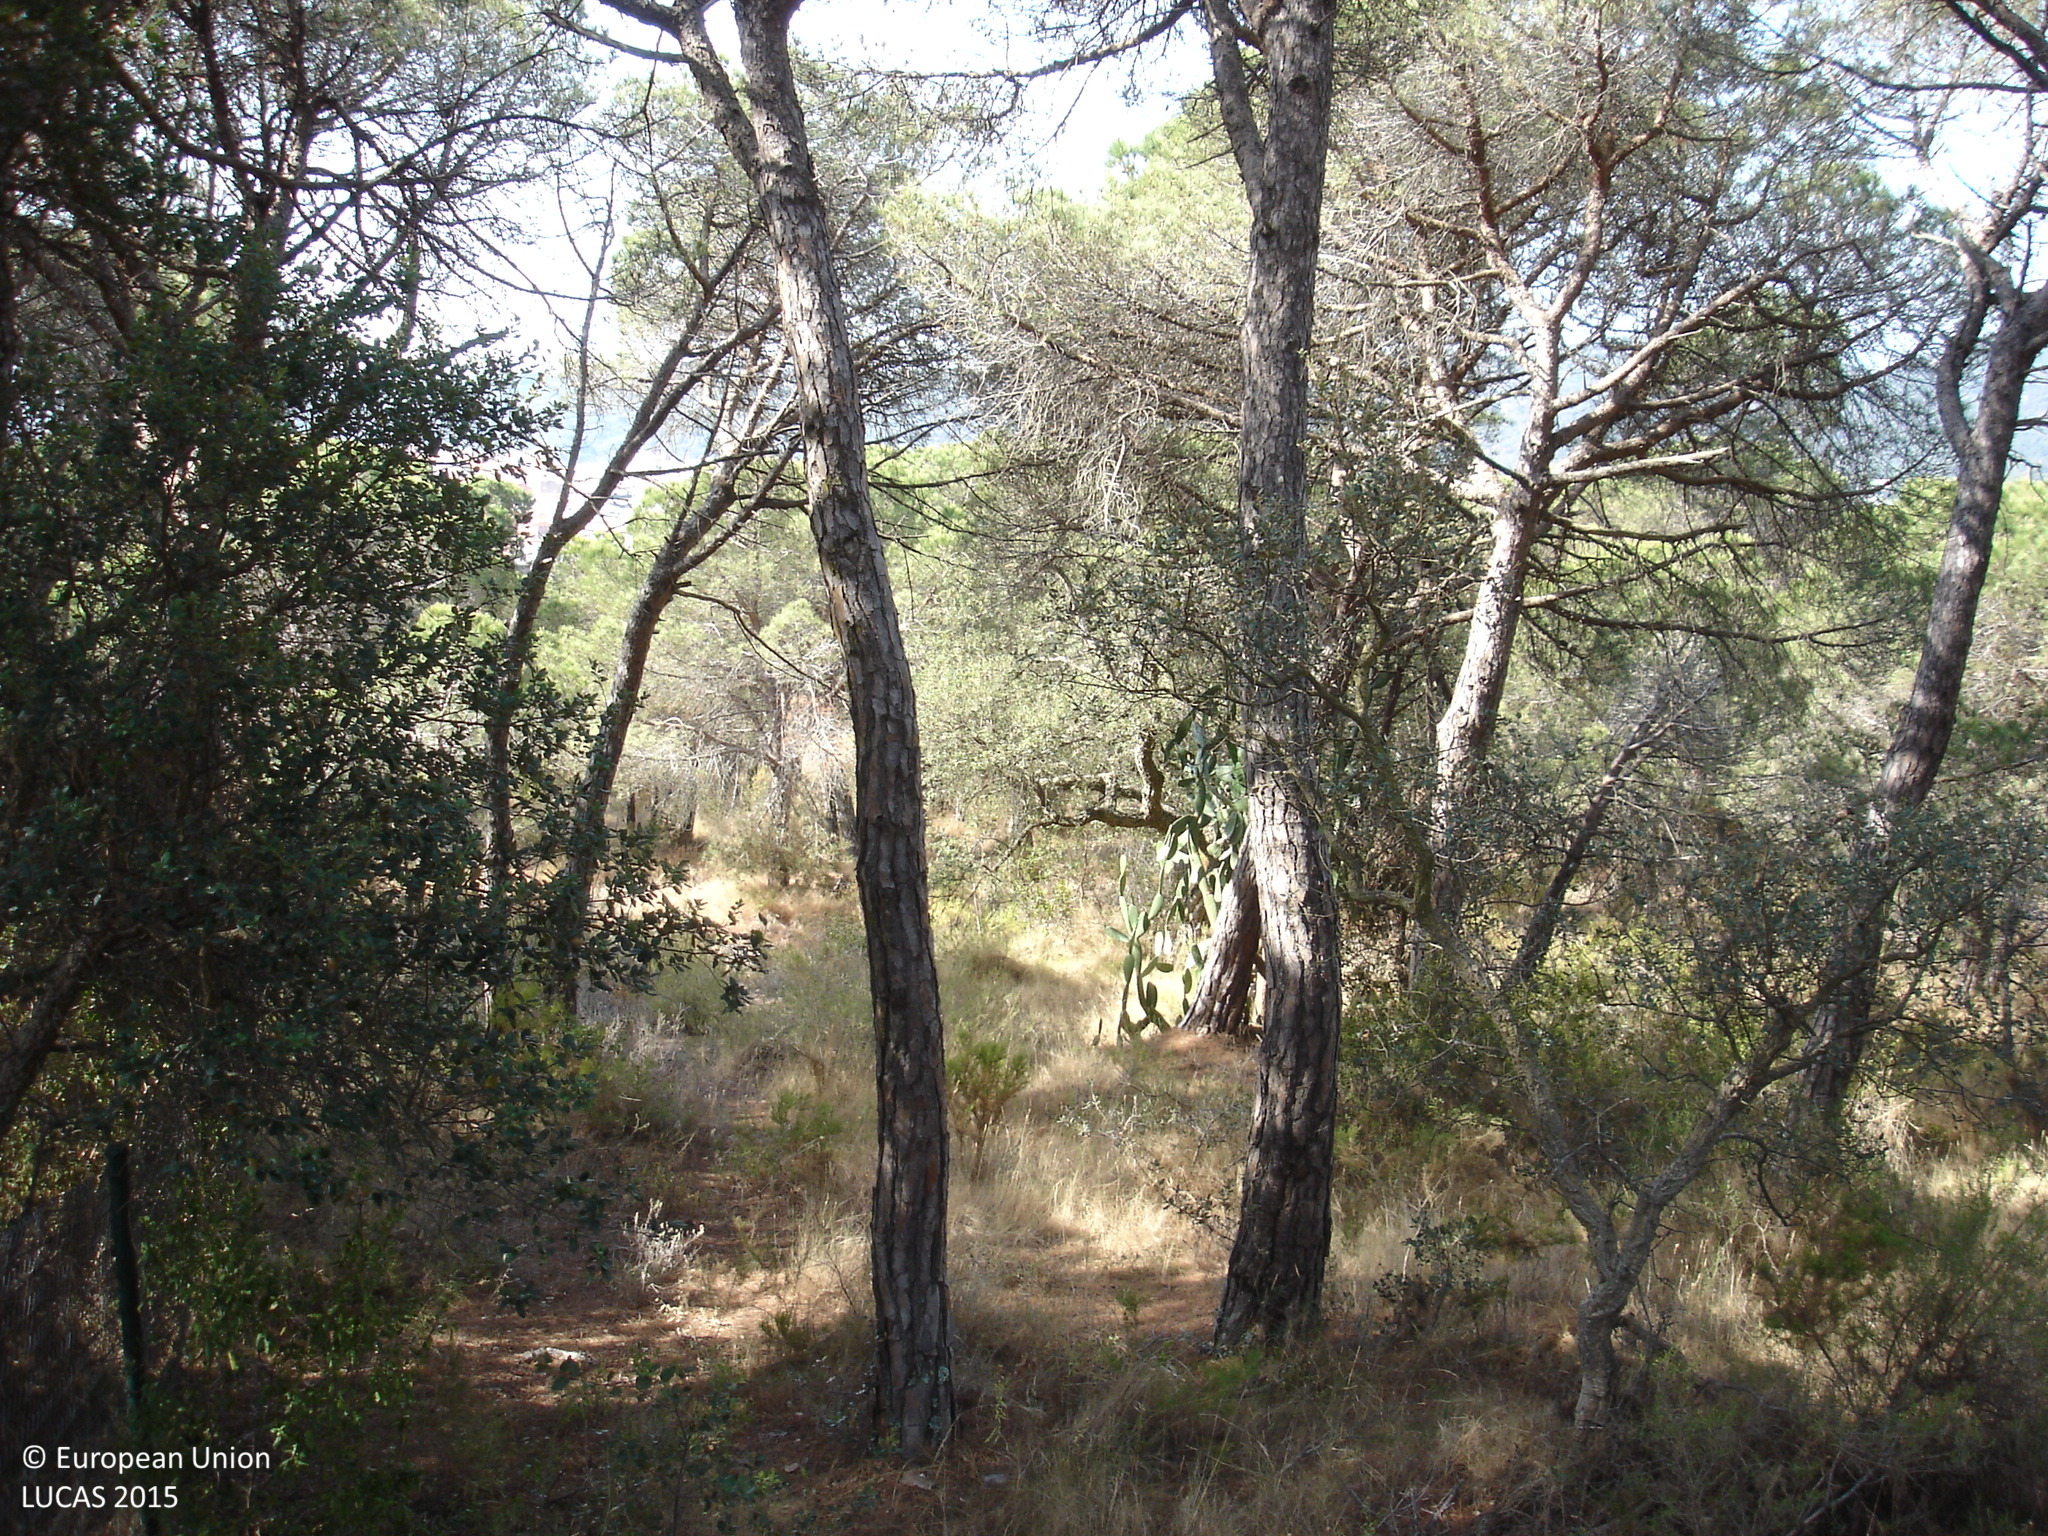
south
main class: Woodland
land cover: Pine dominated coniferous woodland
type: coniferous forest of the mediterranean region
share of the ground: 50 - 75 %
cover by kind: coniferous forest trees 70 %, herbaceous plants 25 %, broadleaved forest trees 5 %
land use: Forestry
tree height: > 5 m
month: July
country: ES
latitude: 41.7971
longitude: 3.0247
